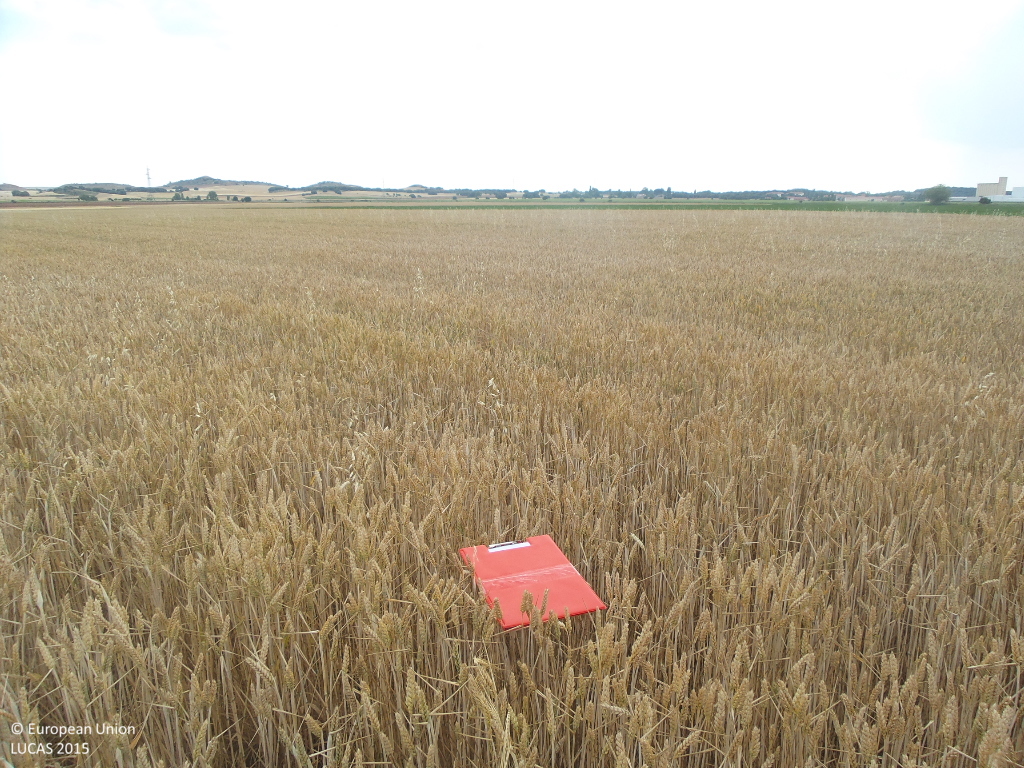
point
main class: Cropland
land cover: Common wheat
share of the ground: > 75 %
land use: Agriculture (excluding fallow land and kitchen gardens)
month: June
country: ES
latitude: 41.5405
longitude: -3.1212
